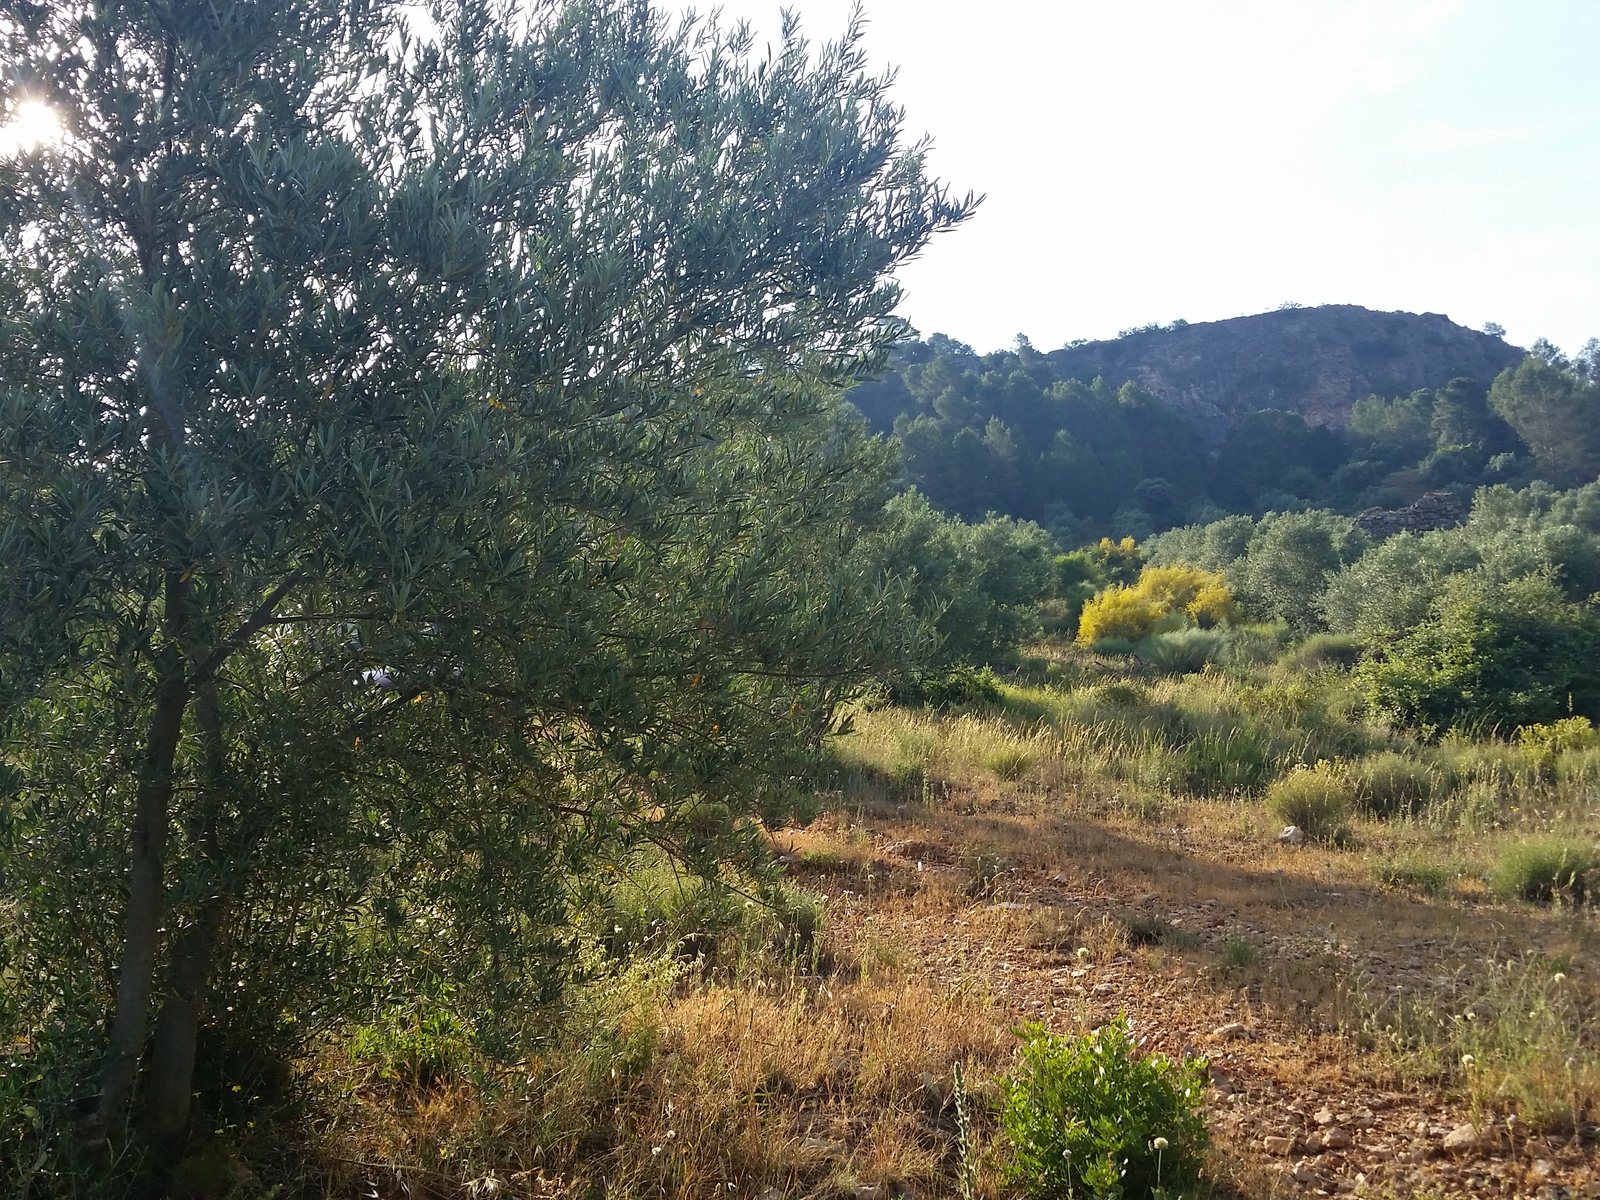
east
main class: Cropland
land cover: Olive groves
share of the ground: 25 - 50 %
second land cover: Grassland without tree/shrub cover
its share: 10 - 25 %
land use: Agriculture (excluding fallow land and kitchen gardens)
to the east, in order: Olive groves; Grassland without tree/shrub cover; Pine dominated coniferous woodland; Tracks; Pine dominated coniferous woodland
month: June
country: ES
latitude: 38.4372
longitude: -2.5202
